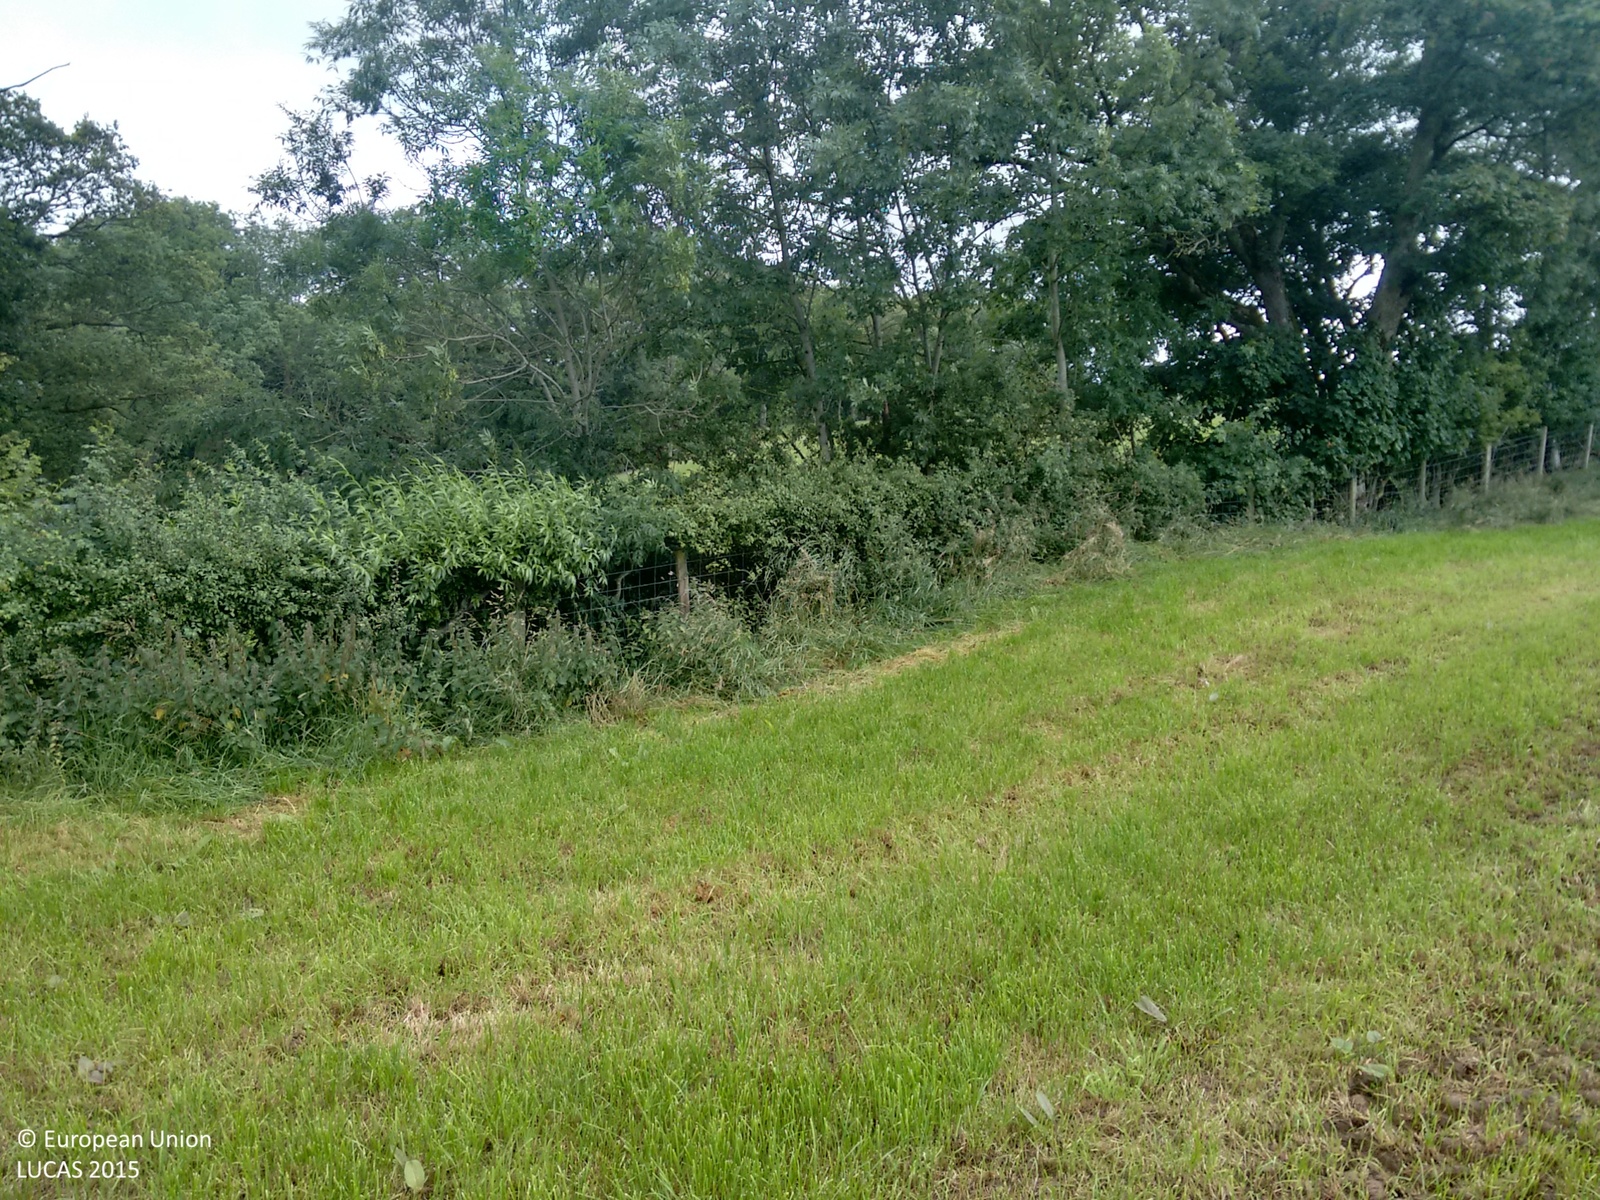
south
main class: Grassland
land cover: Grassland without tree/shrub cover
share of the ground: > 75 %
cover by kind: herbaceous plants 100 %
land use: Agriculture (excluding fallow land and kitchen gardens)
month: August
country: GB
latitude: 54.7617
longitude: -2.9545
